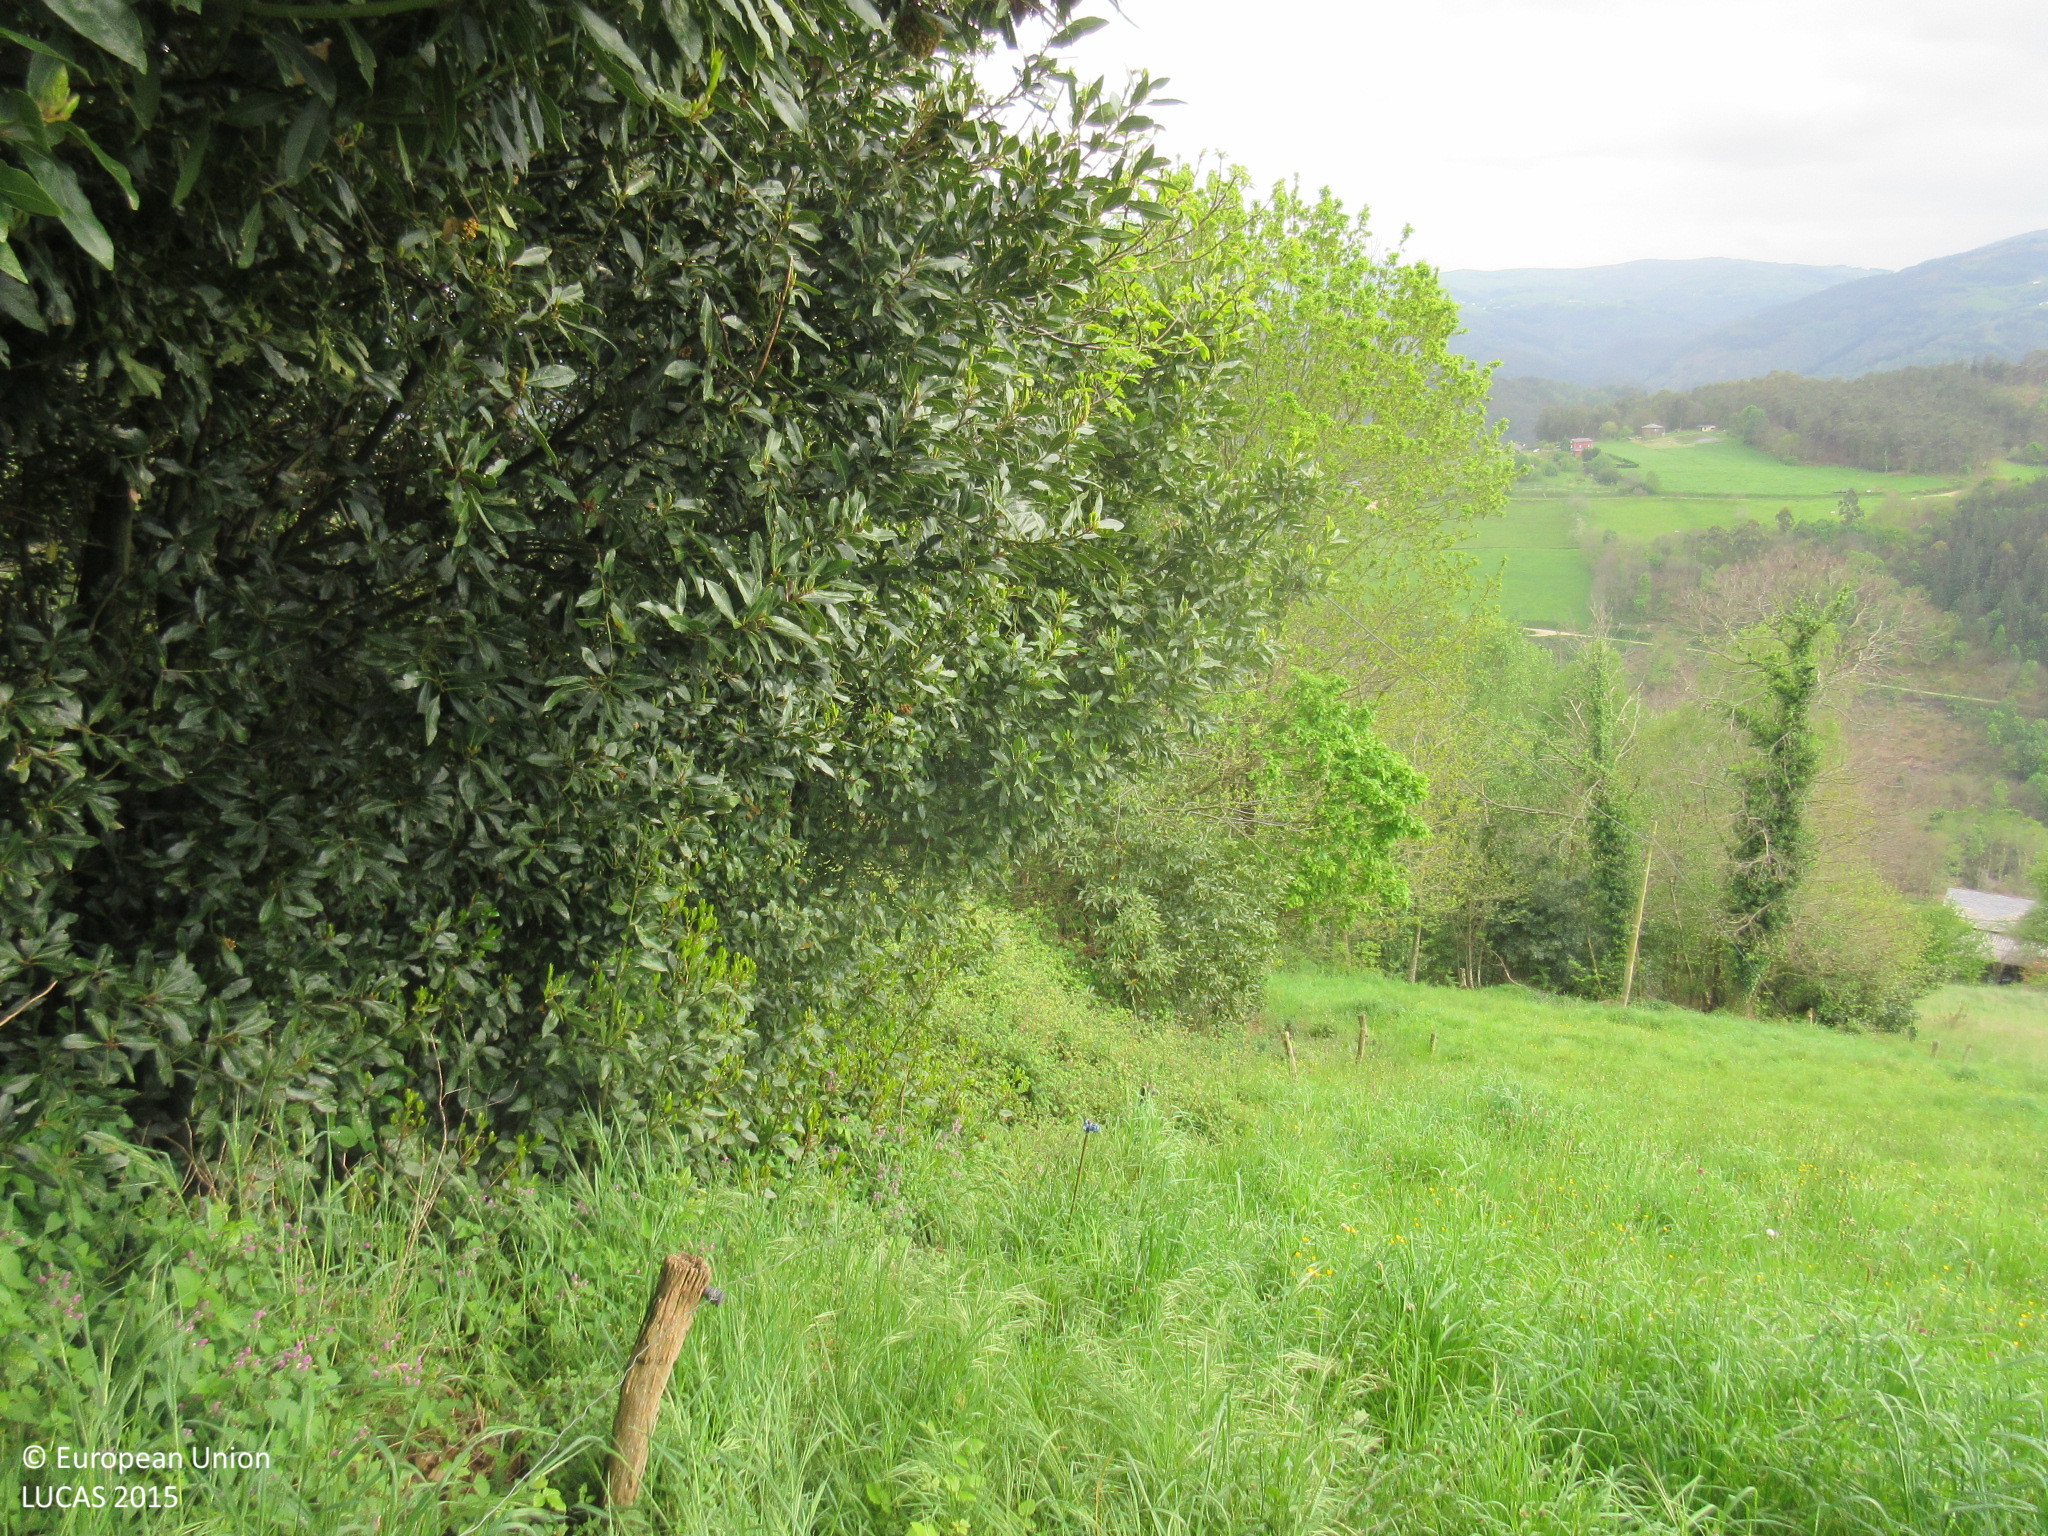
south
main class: Grassland
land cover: Grassland without tree/shrub cover
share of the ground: > 75 %
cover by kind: herbaceous plants 100 %
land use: Agriculture (excluding fallow land and kitchen gardens)
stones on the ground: 10 - 25 %
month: April
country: ES
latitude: 43.4923
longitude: -6.4130
